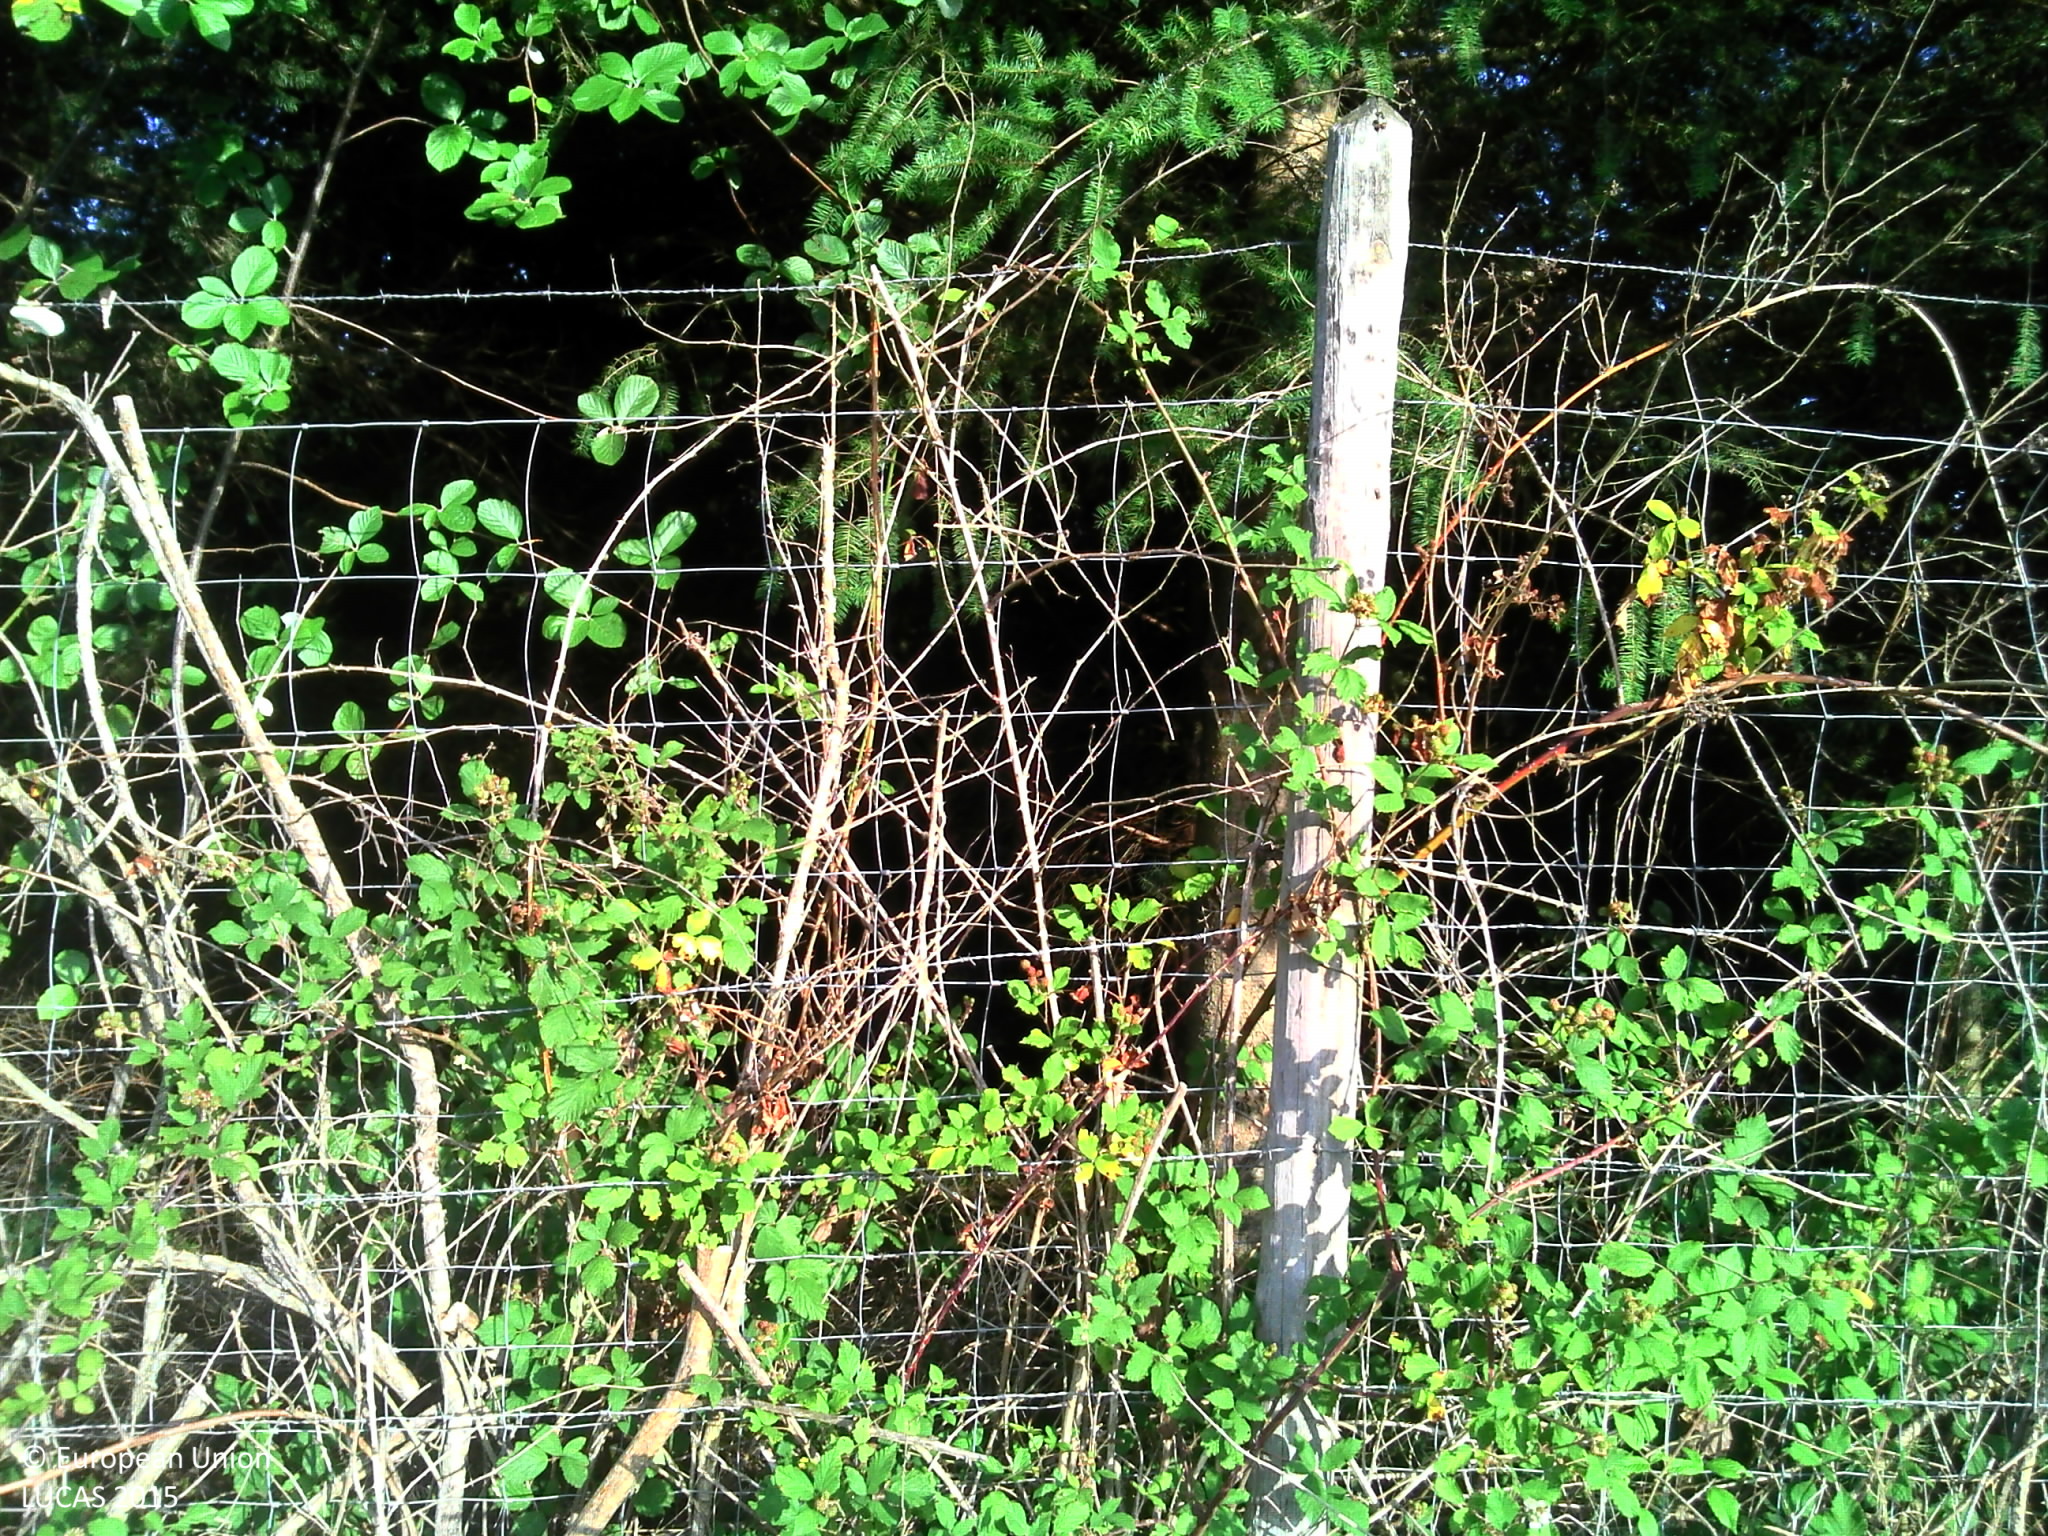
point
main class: Woodland
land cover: Pine dominated mixed woodland
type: exotic forest
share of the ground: > 75 %
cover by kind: broadleaved forest trees 50 %, coniferous forest trees 30 %, herbaceous plants 20 %
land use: Forestry
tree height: > 5 m
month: July
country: FR
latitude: 45.2701
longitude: 4.1536
